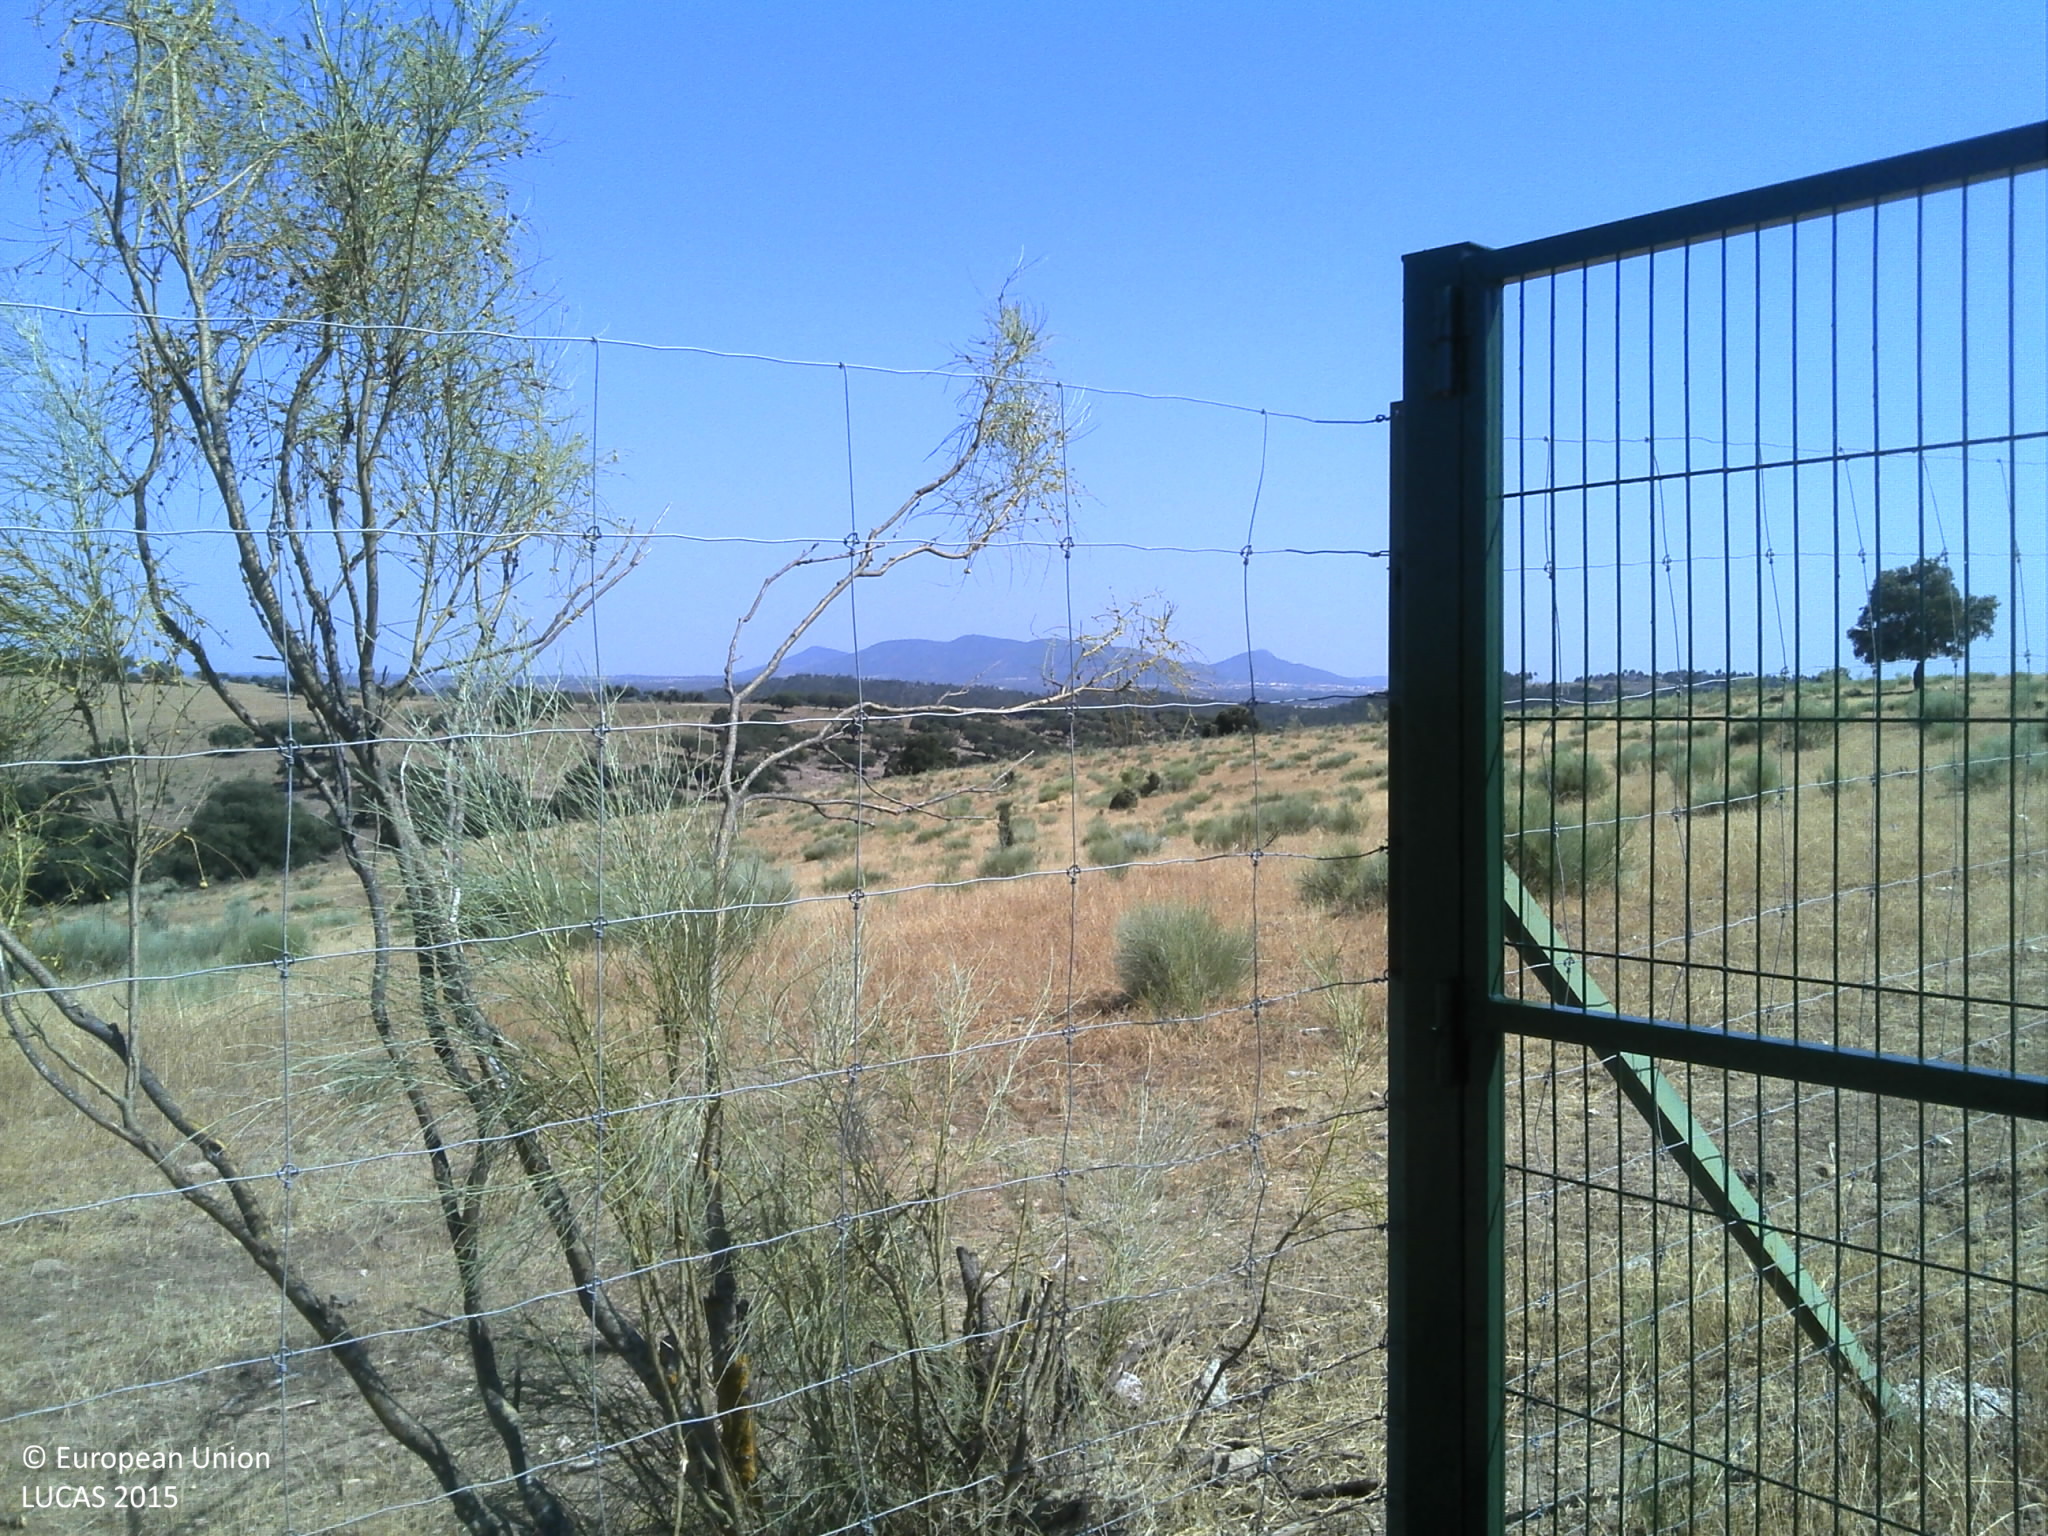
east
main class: Woodland
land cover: Broadleaved woodland
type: broadleaved evergreen forest
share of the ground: 25 - 50 %
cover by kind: herbaceous plants 70 %, broadleaved forest trees 30 %
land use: Forestry
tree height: > 5 m
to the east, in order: Broadleaved woodland; Grassland without tree/shrub cover; Tracks; Shrubland with sparse tree cover; Broadleaved woodland
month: June
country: PT
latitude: 39.6789
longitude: -7.2884
